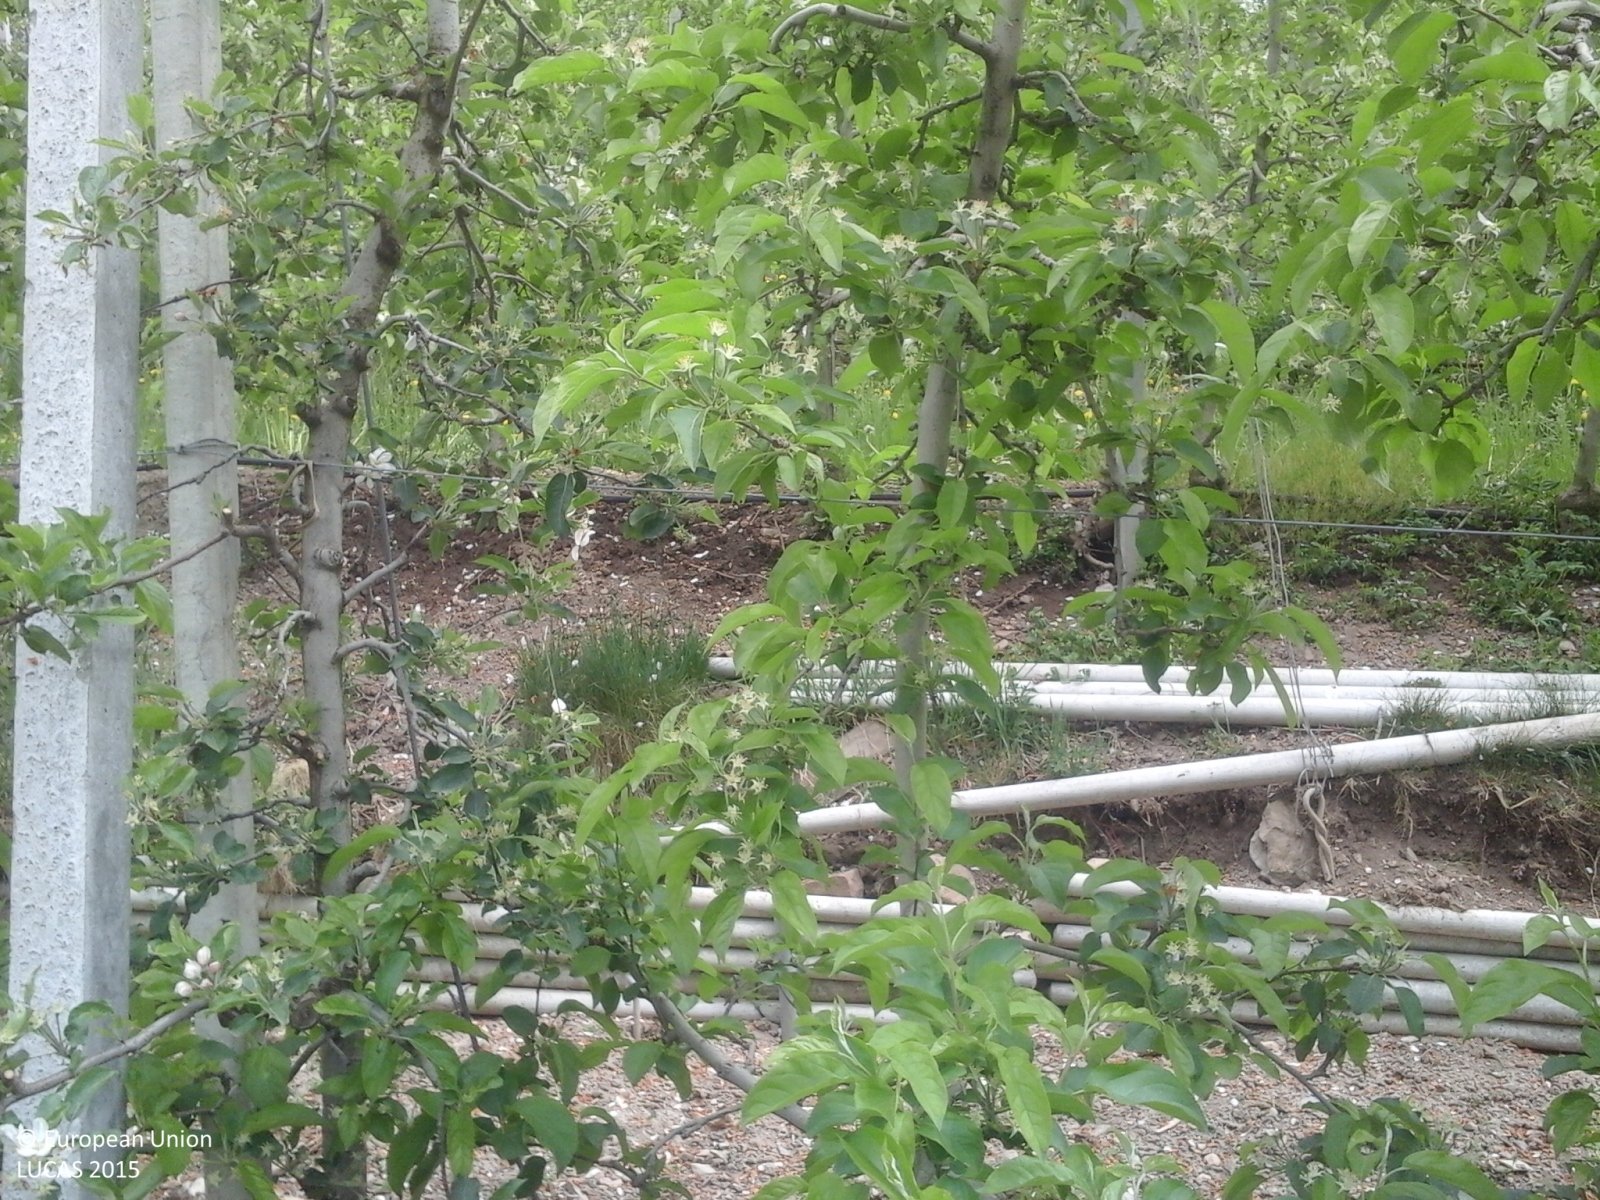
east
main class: Cropland
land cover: Apple fruit
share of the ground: 25 - 50 %
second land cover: Grassland without tree/shrub cover
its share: > 75 %
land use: Agriculture (excluding fallow land and kitchen gardens)
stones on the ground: < 10 %
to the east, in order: Apple fruit; Grassland without tree/shrub cover; Tracks; Apple fruit; Paved roads, cycling and walking lanes; Apple fruit; Paved roads, cycling and walking lanes; Apple fruit
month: April
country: IT
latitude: 46.3098
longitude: 11.0763
